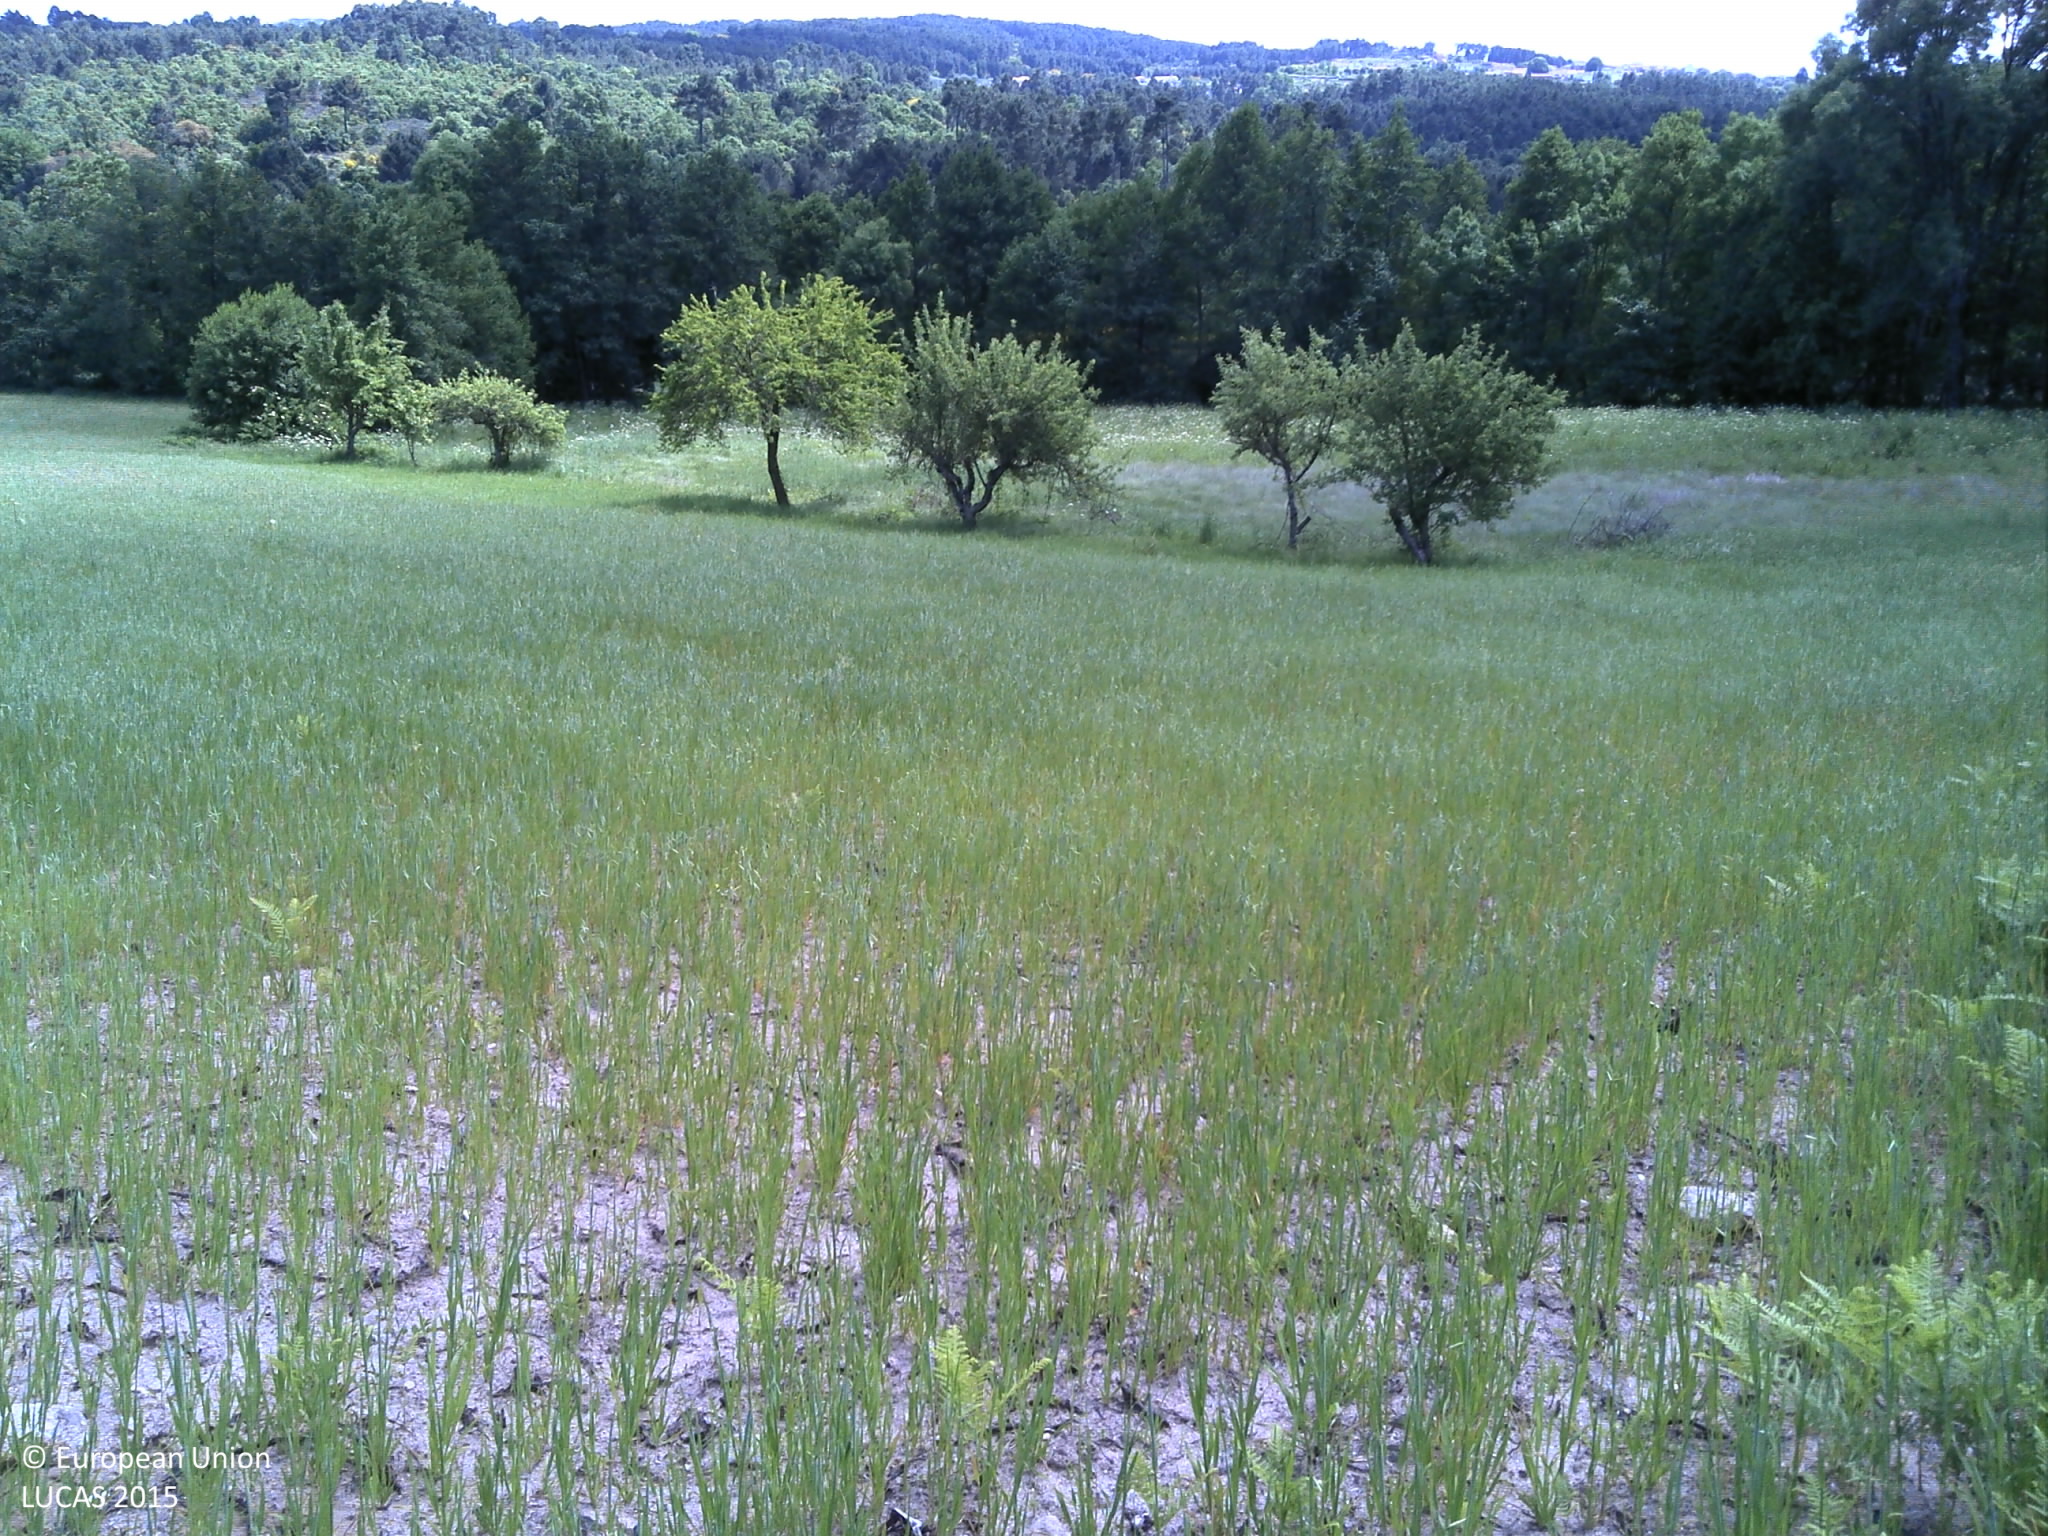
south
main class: Cropland
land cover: Oats
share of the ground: 25 - 50 %
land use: Agriculture (excluding fallow land and kitchen gardens)
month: May
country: PT
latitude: 41.6988
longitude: -7.5431
